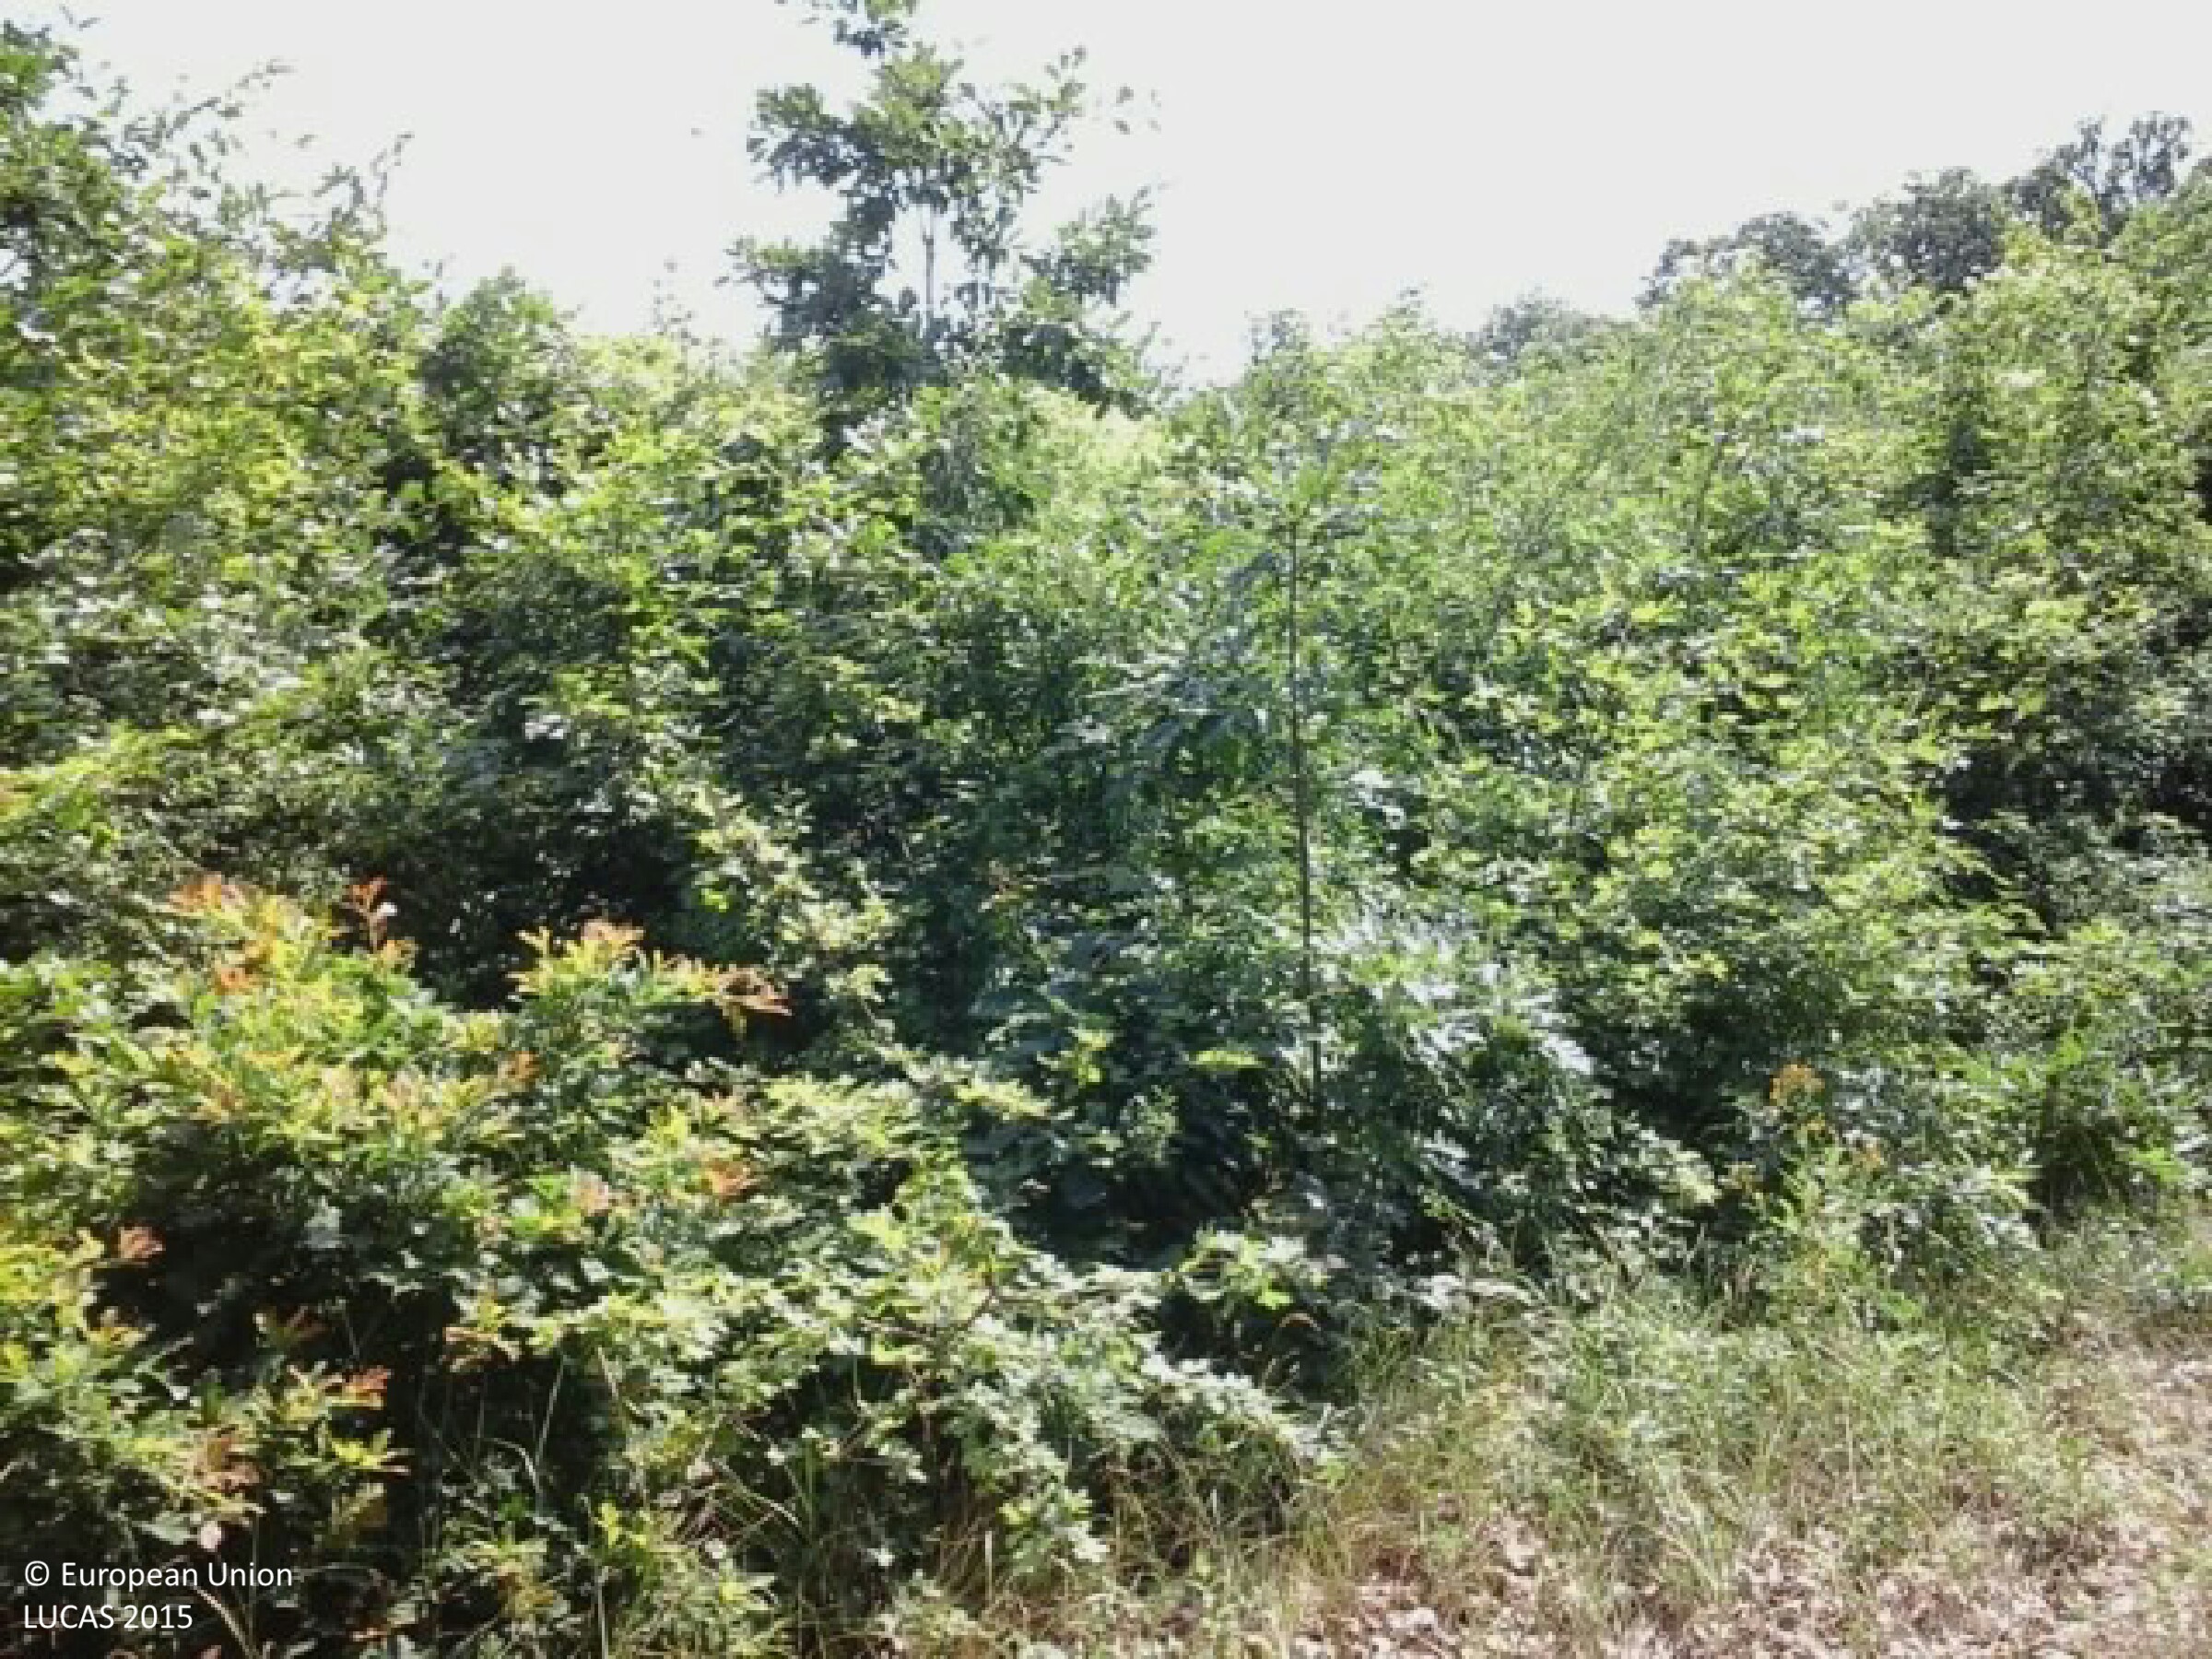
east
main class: Woodland
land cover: Broadleaved woodland
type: mesophytic deciduous forest
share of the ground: > 75 %
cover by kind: broadleaved forest trees 100 %
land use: Forestry
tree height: < 5 m
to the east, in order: Broadleaved woodland; Grass margins; Tracks; Grass margins; Broadleaved woodland
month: July
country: HU
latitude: 47.7355
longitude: 19.3420
